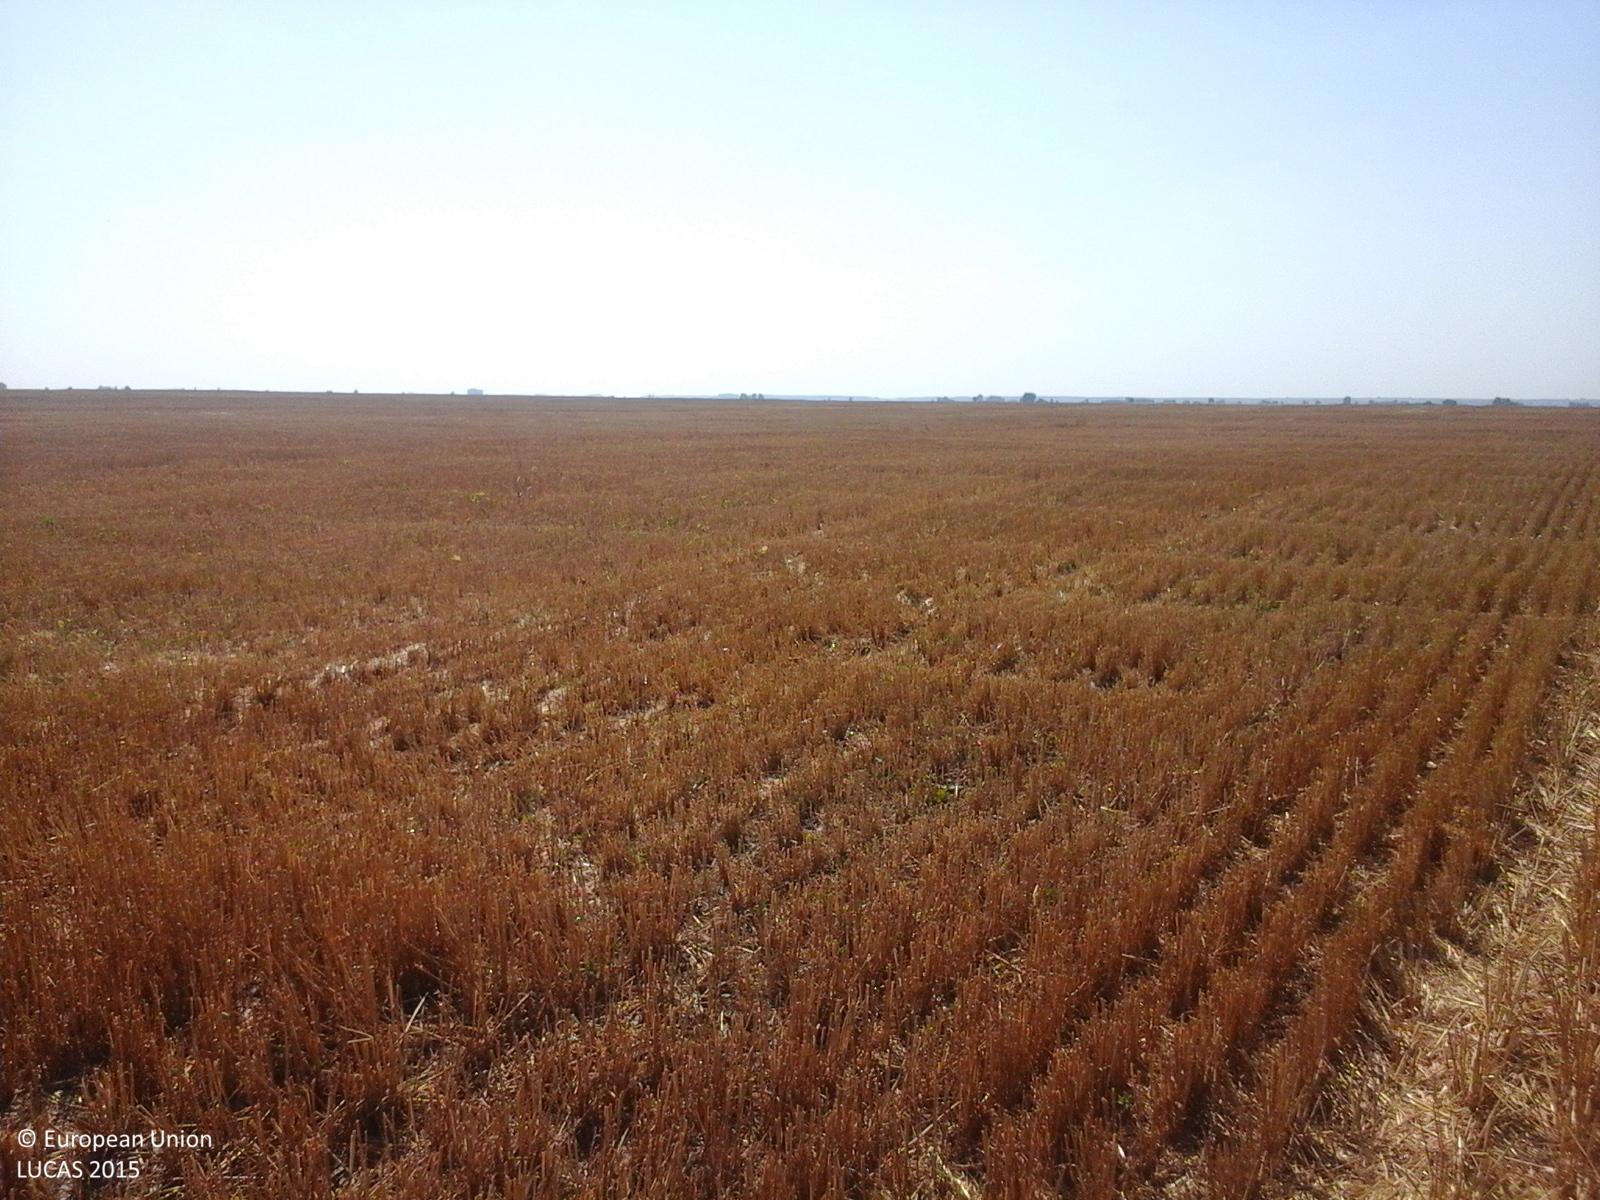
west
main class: Cropland
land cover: Common wheat
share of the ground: < 10 %
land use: Agriculture (excluding fallow land and kitchen gardens)
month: July
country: RO
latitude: 44.3325
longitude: 27.9761
